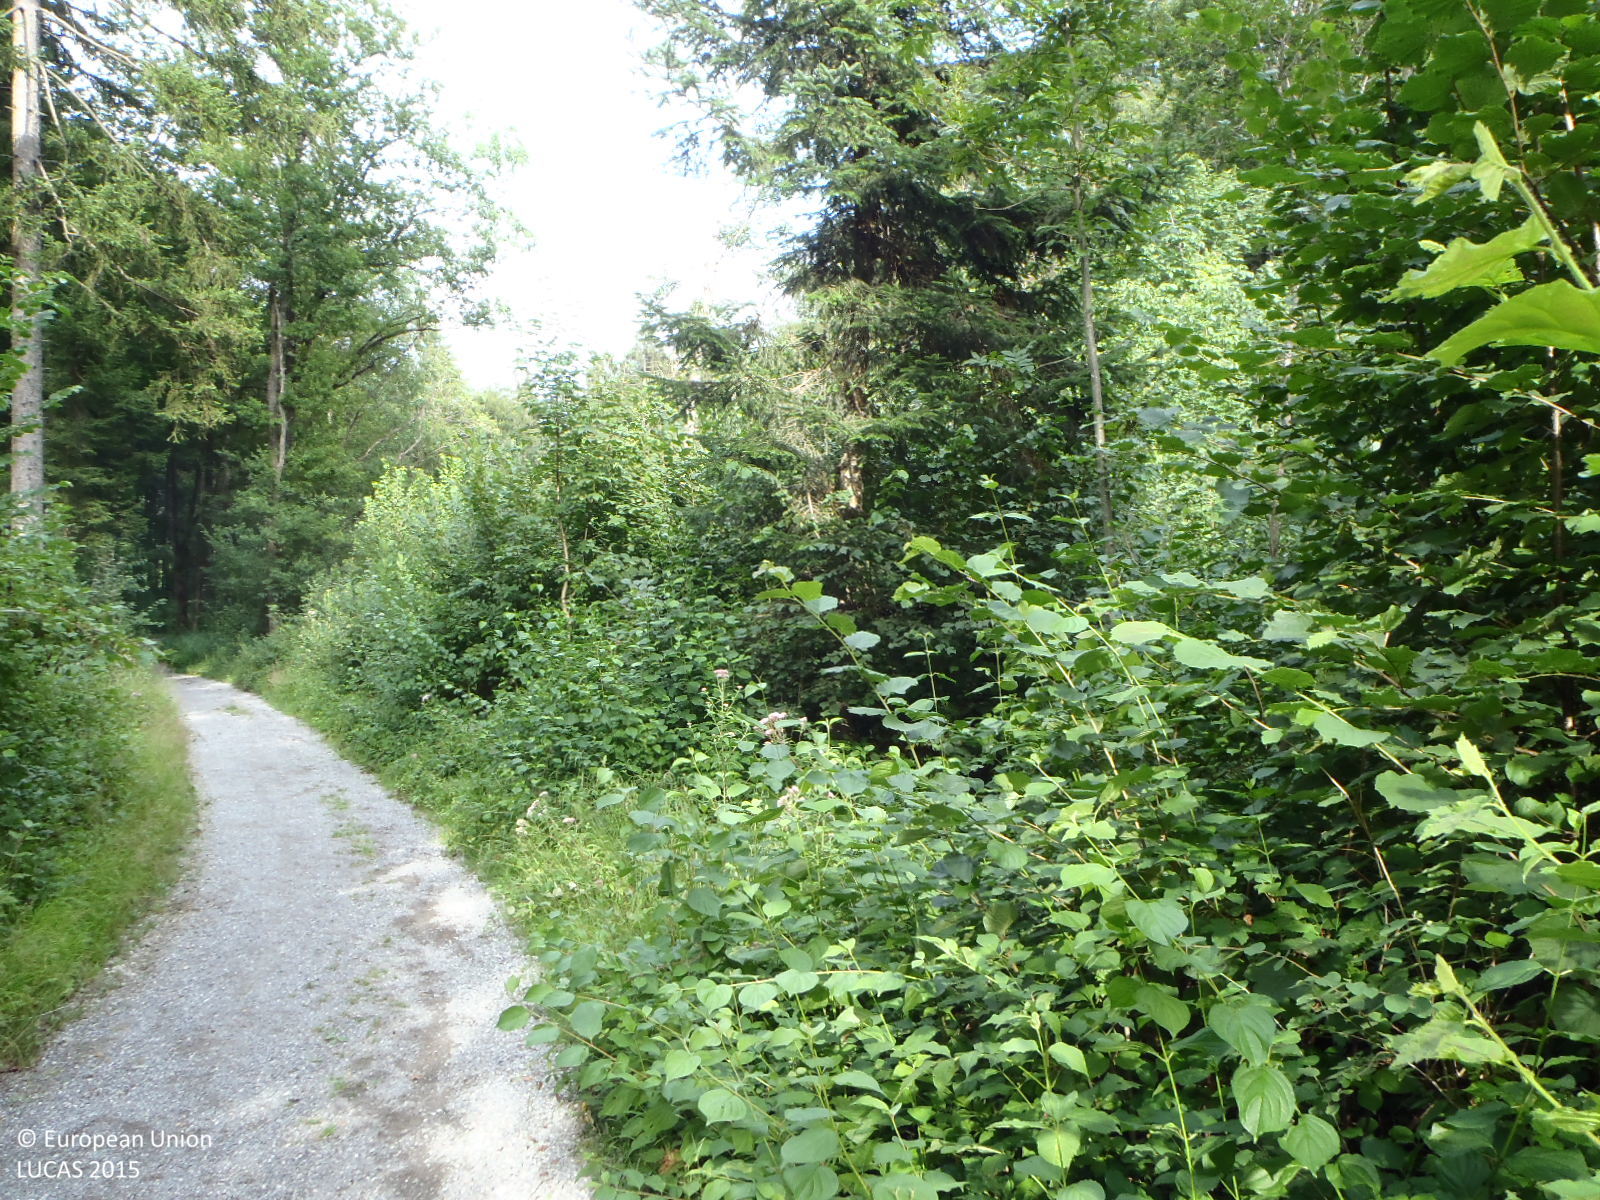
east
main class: Woodland
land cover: Broadleaved woodland
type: mountainous beech forest
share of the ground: > 75 %
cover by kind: broadleaved forest trees 50 %, shrubs 30 %, herbaceous plants 20 %
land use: Forestry
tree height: > 5 m
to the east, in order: Broadleaved woodland; Rivers and streams; Spruce dominated mixed woodland; Tracks; Other mixed woodland
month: July
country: AT
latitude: 47.1971
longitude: 9.6703
